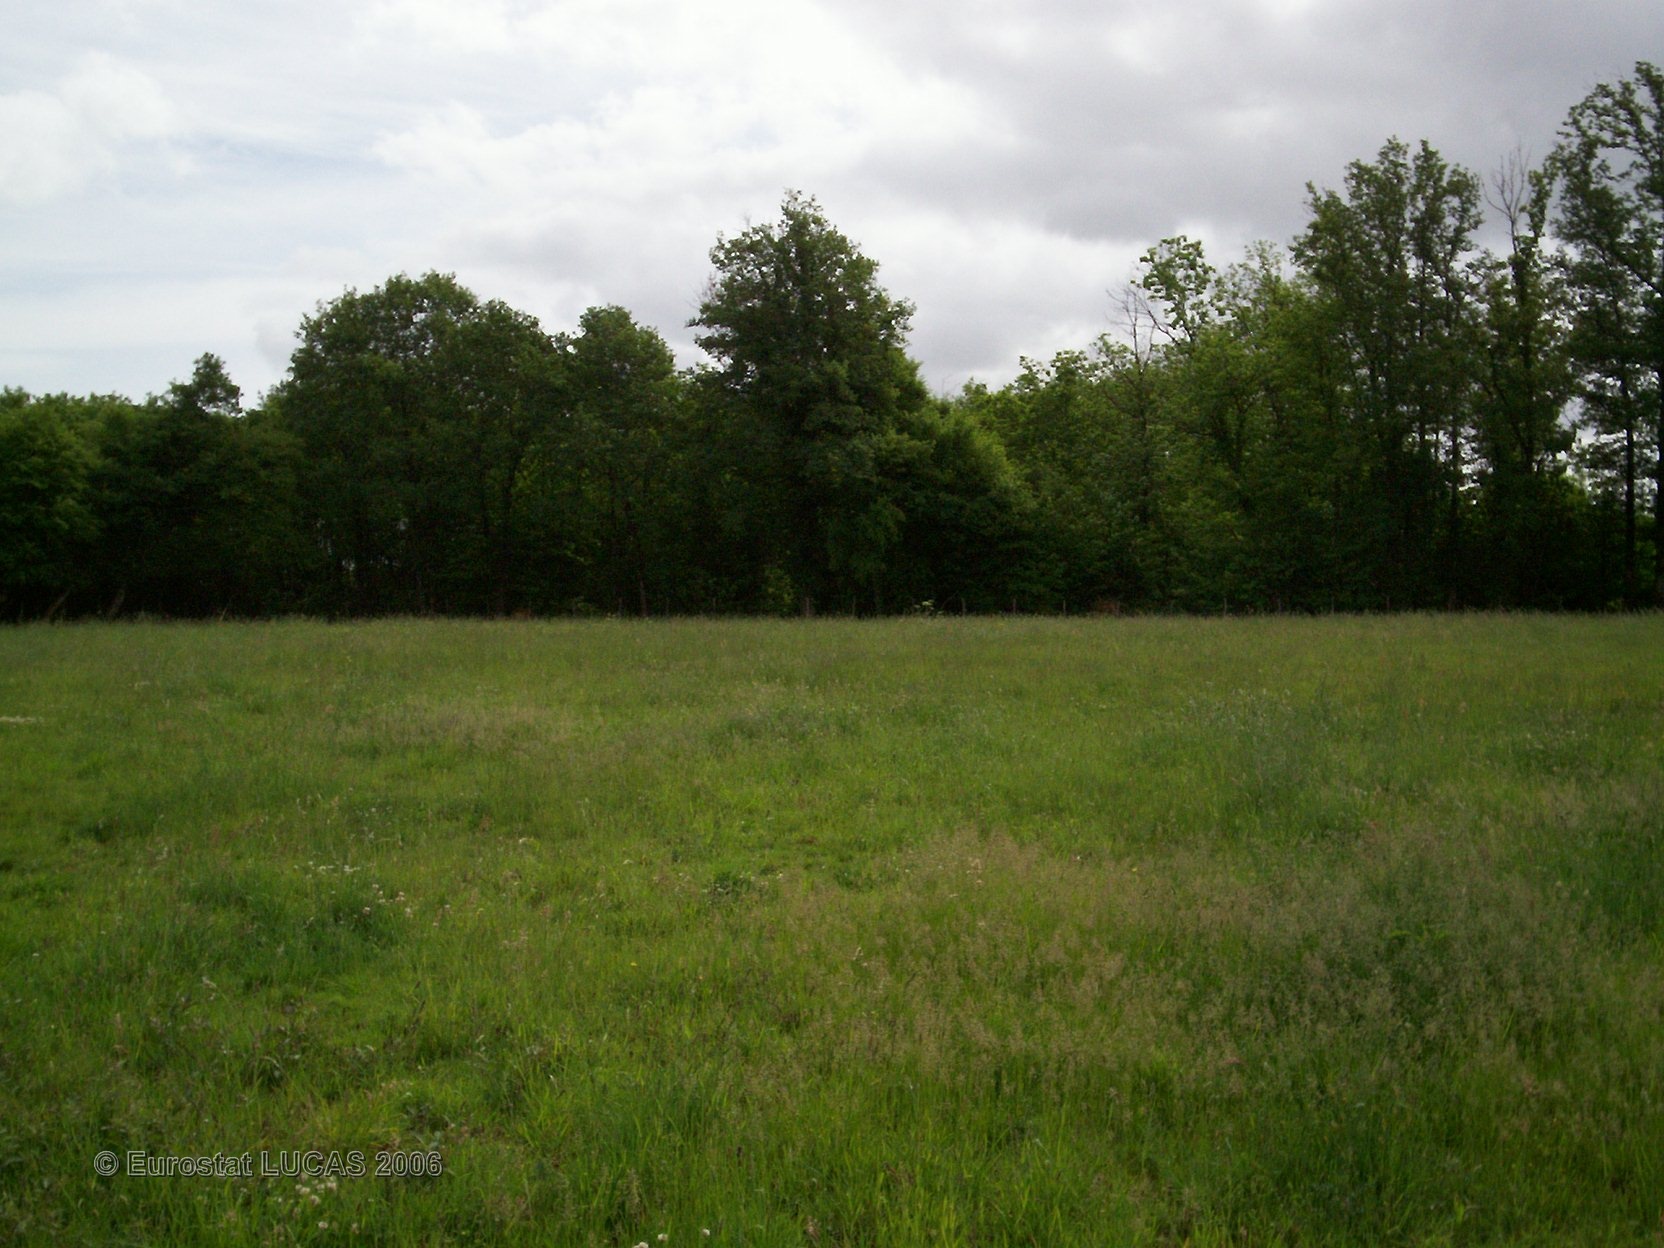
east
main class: Grassland
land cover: Grassland without tree/shrub cover
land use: Agriculture (excluding fallow land and kitchen gardens)
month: May
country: FR
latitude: 45.8746
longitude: 0.5161
